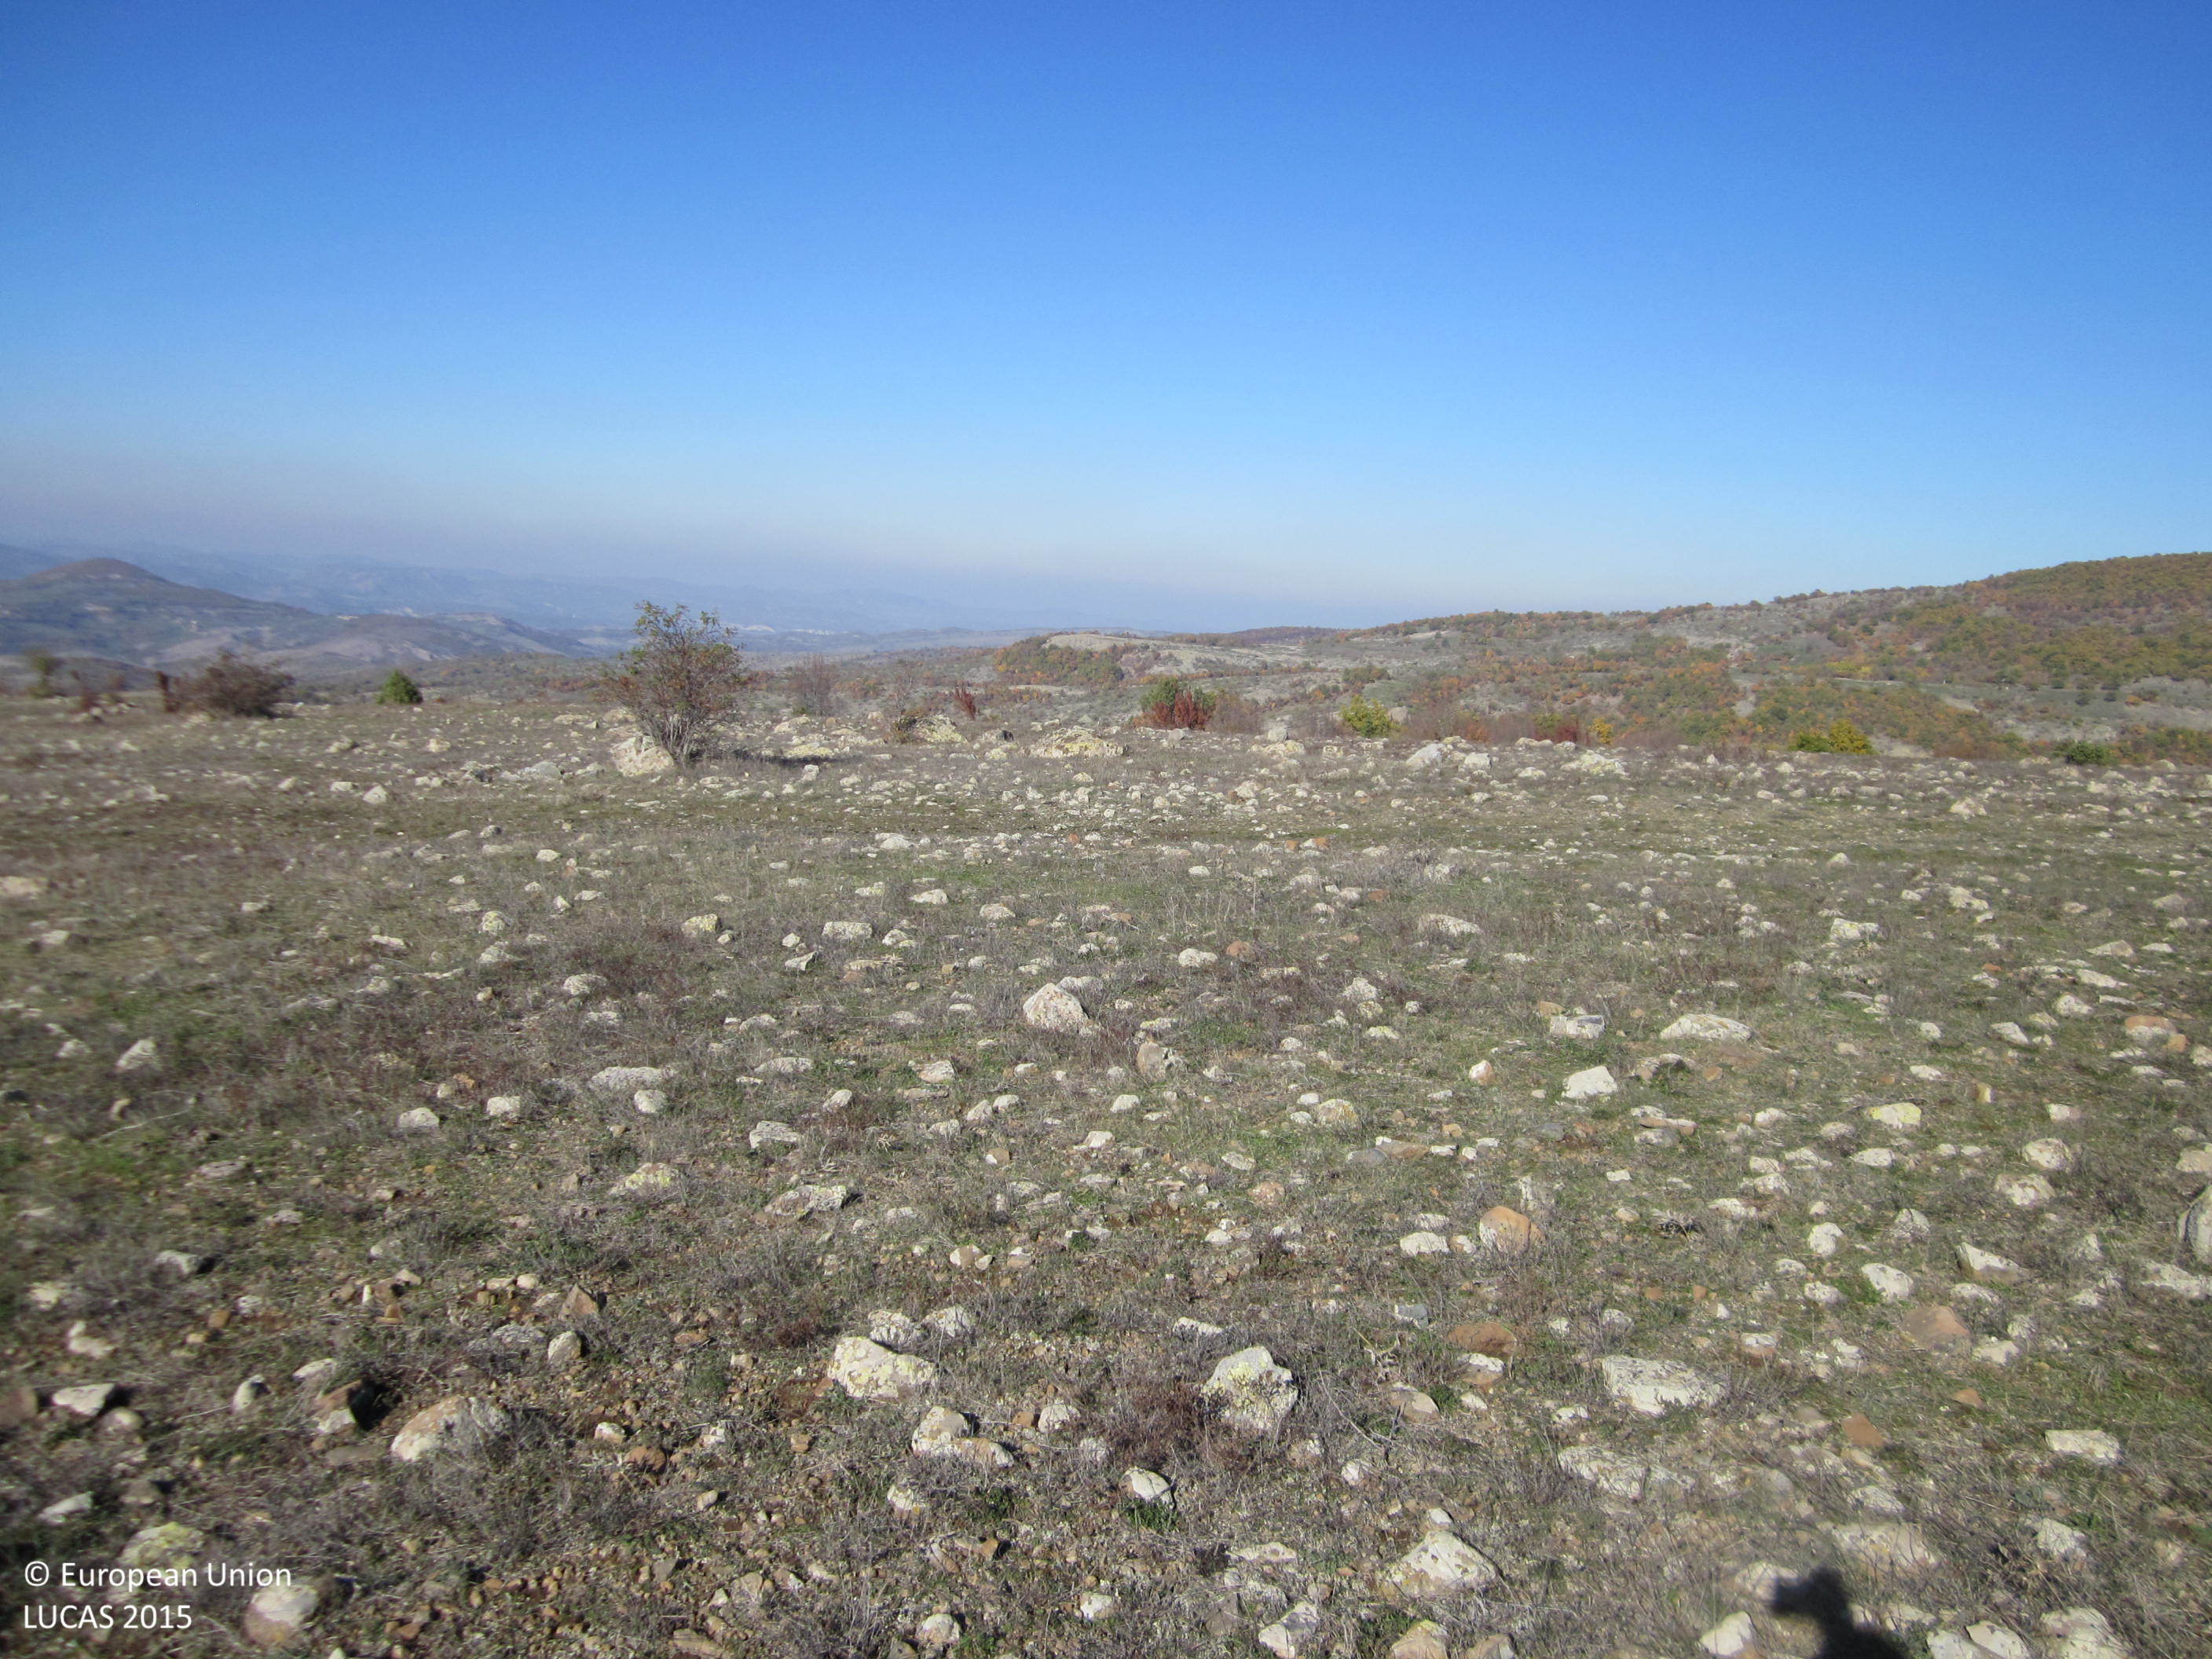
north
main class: Grassland
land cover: Grassland without tree/shrub cover
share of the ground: > 75 %
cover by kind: herbaceous plants 80 %, unconsolidated bare surface 20 %
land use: Agriculture (excluding fallow land and kitchen gardens)
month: November
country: BG
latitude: 41.4953
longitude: 25.6934
